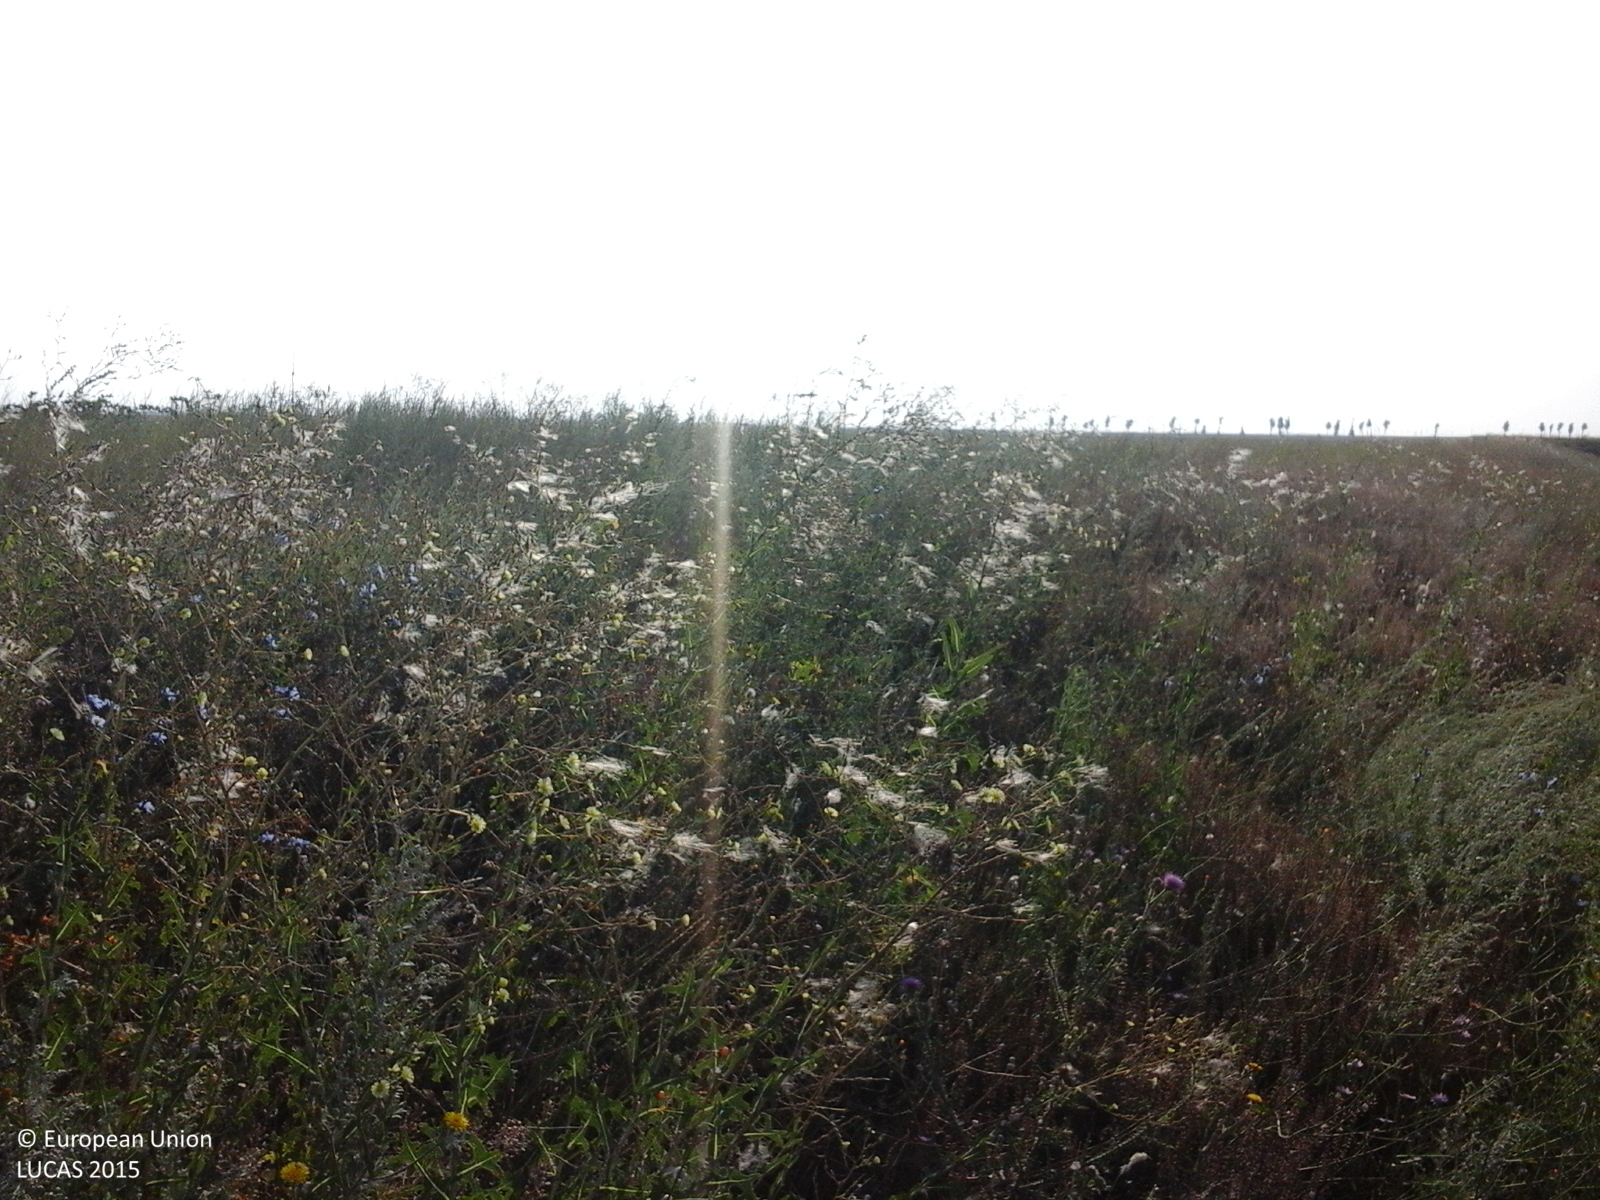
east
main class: Grassland
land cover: Spontaneously vegetated surfaces
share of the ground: > 75 %
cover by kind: herbaceous plants 100 %
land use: Fallow land
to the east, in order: Spontaneously vegetated surfaces; Tracks; Spontaneously vegetated surfaces; Other bare soil; Common wheat
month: July
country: RO
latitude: 44.6536
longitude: 27.0678
